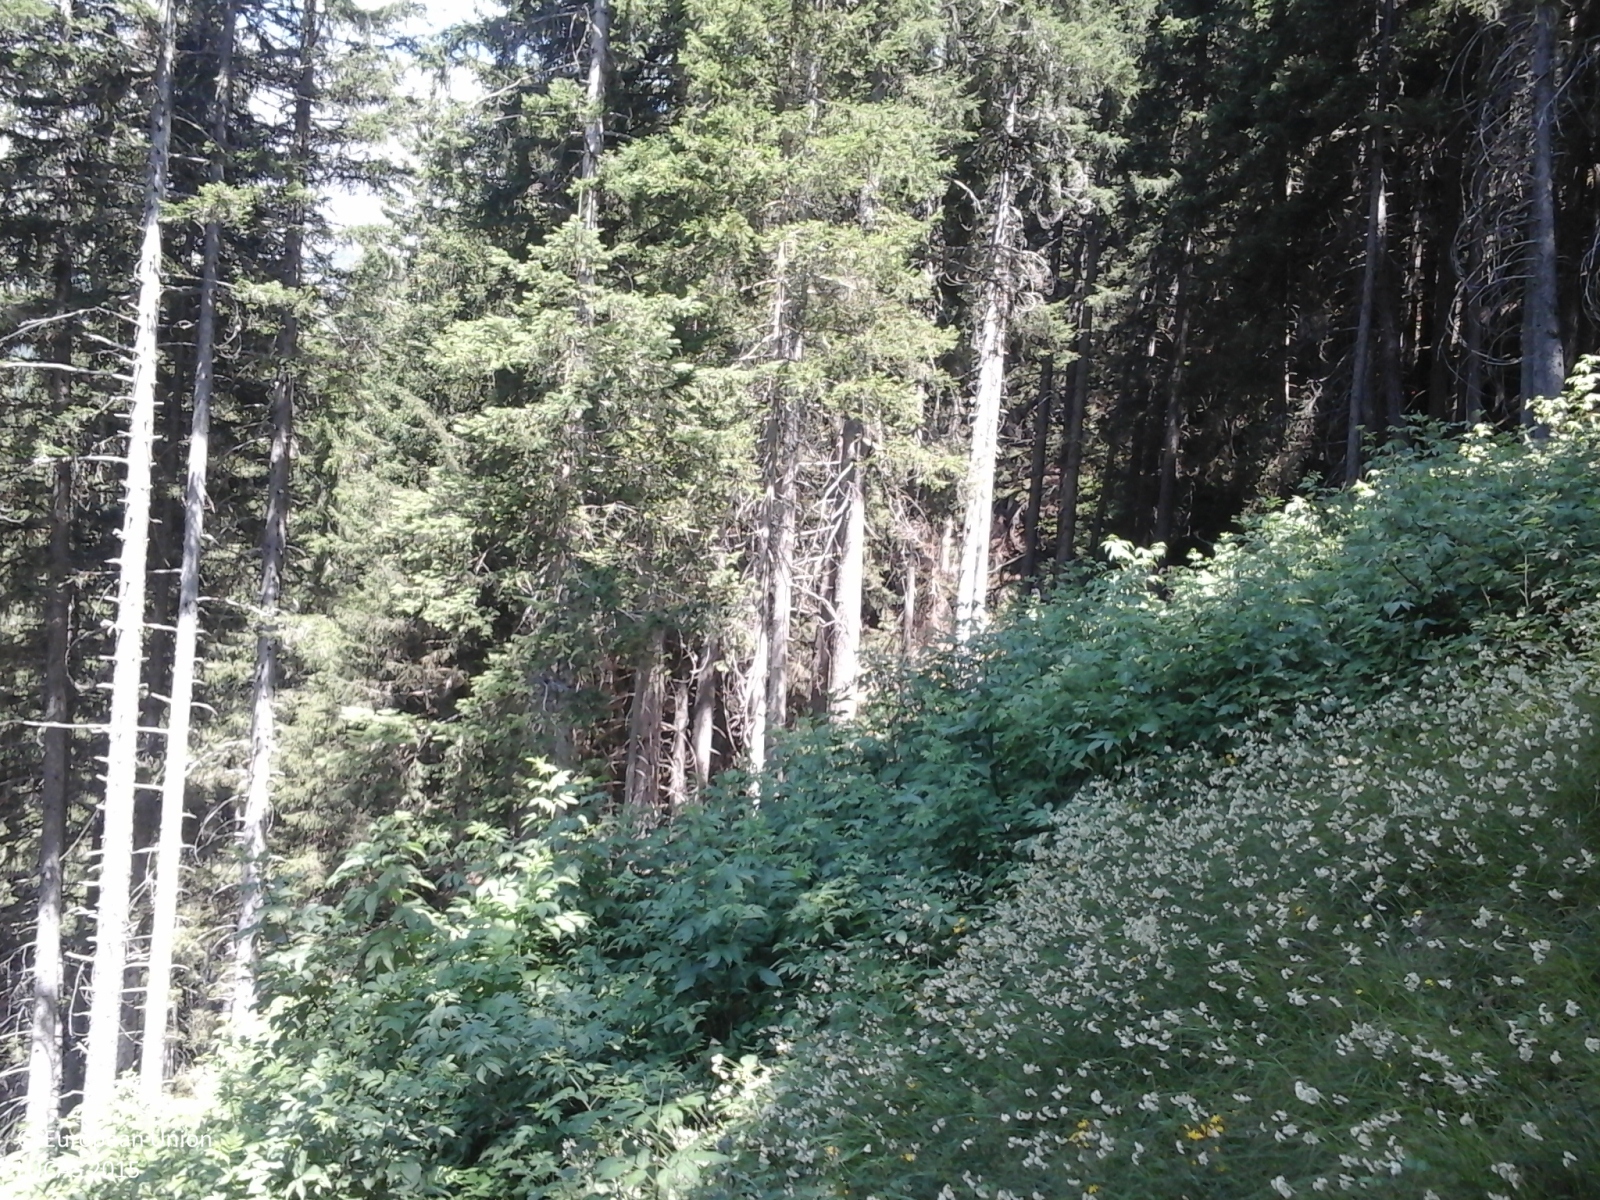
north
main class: Woodland
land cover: Spruce dominated coniferous woodland
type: alpine coniferous forest
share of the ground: > 75 %
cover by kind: coniferous forest trees 100 %
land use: Forestry
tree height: > 5 m
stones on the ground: 10 - 25 %
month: July
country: IT
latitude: 46.4769
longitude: 10.2732
